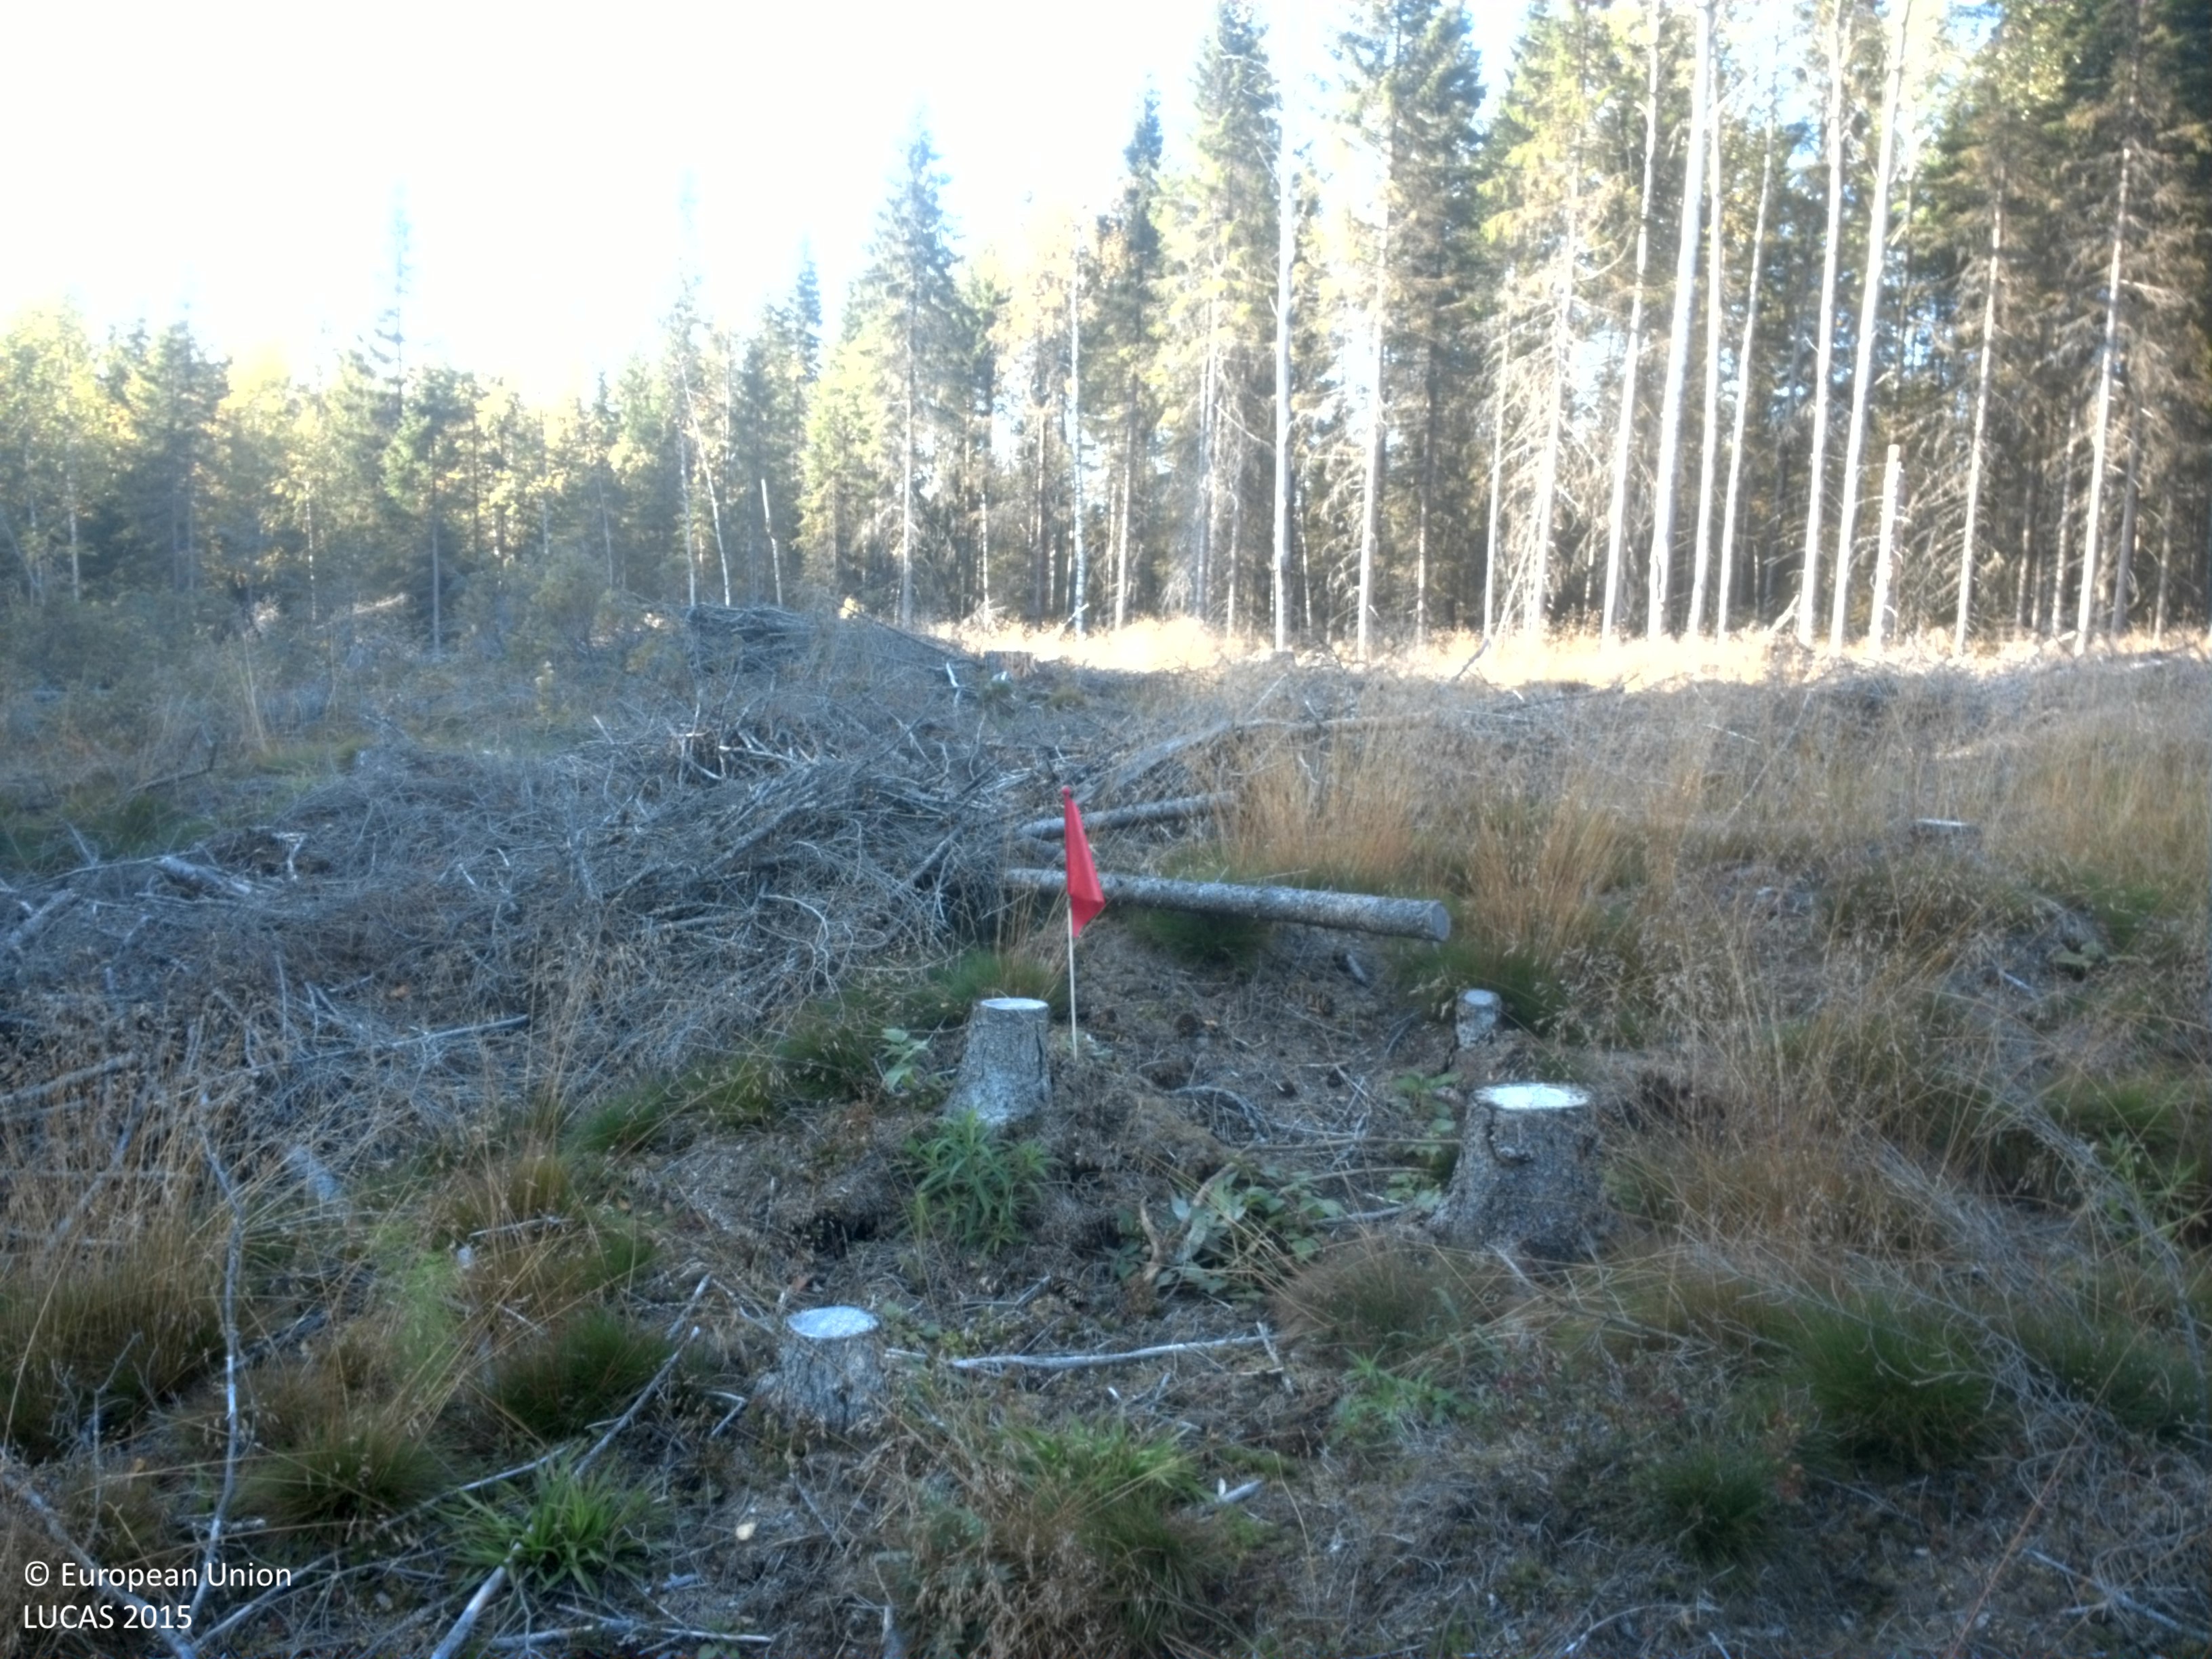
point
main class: Grassland
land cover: Grassland without tree/shrub cover
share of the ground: 50 - 75 %
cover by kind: herbaceous plants 60 %, lichens and mosses 15 %, shrubs 5 %
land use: Forestry
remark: Clear cut
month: September
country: SE
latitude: 64.3046
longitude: 20.5006
